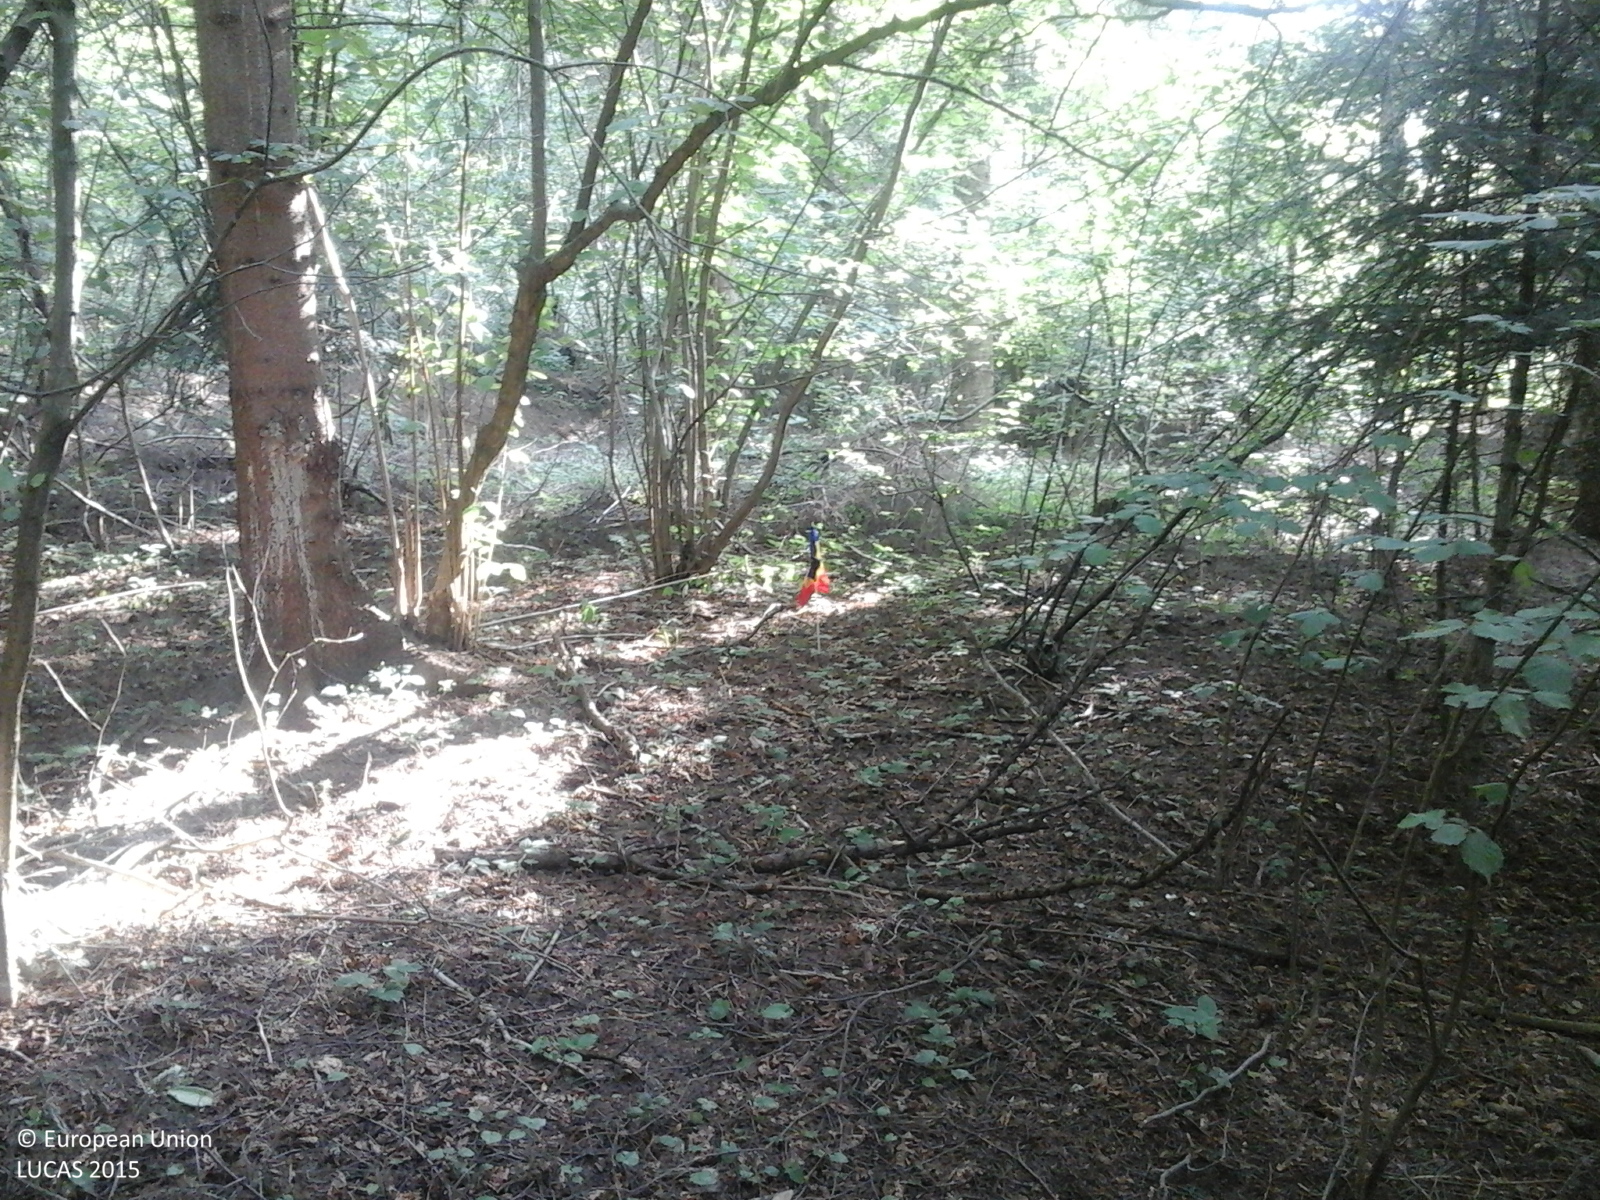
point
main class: Woodland
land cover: Spruce dominated mixed woodland
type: alpine coniferous forest
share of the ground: > 75 %
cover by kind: coniferous forest trees 75 %, broadleaved forest trees 25 %
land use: Forestry
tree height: > 5 m
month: June
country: RO
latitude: 47.6929
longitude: 25.8347
